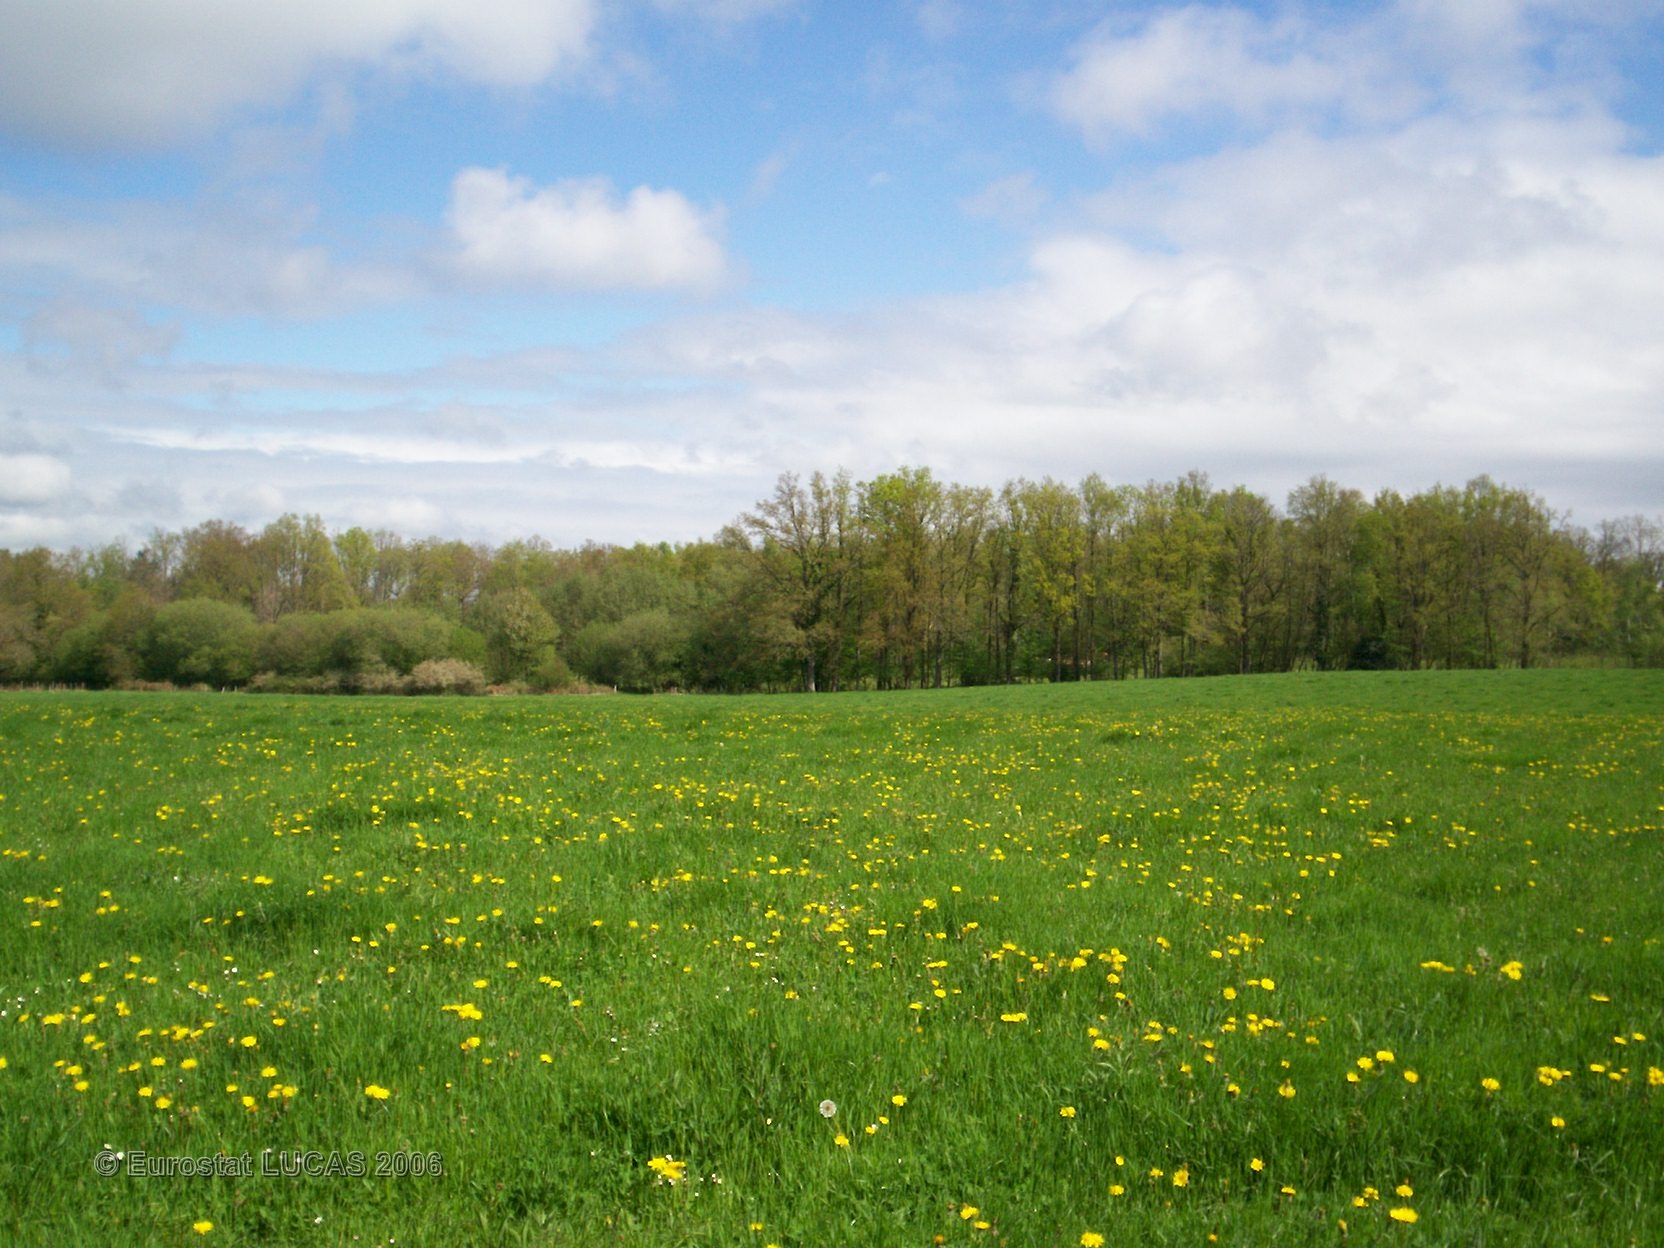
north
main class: Grassland
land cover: Grassland without tree/shrub cover
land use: Agriculture (excluding fallow land and kitchen gardens)
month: April
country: FR
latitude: 45.7141
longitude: 0.7513
